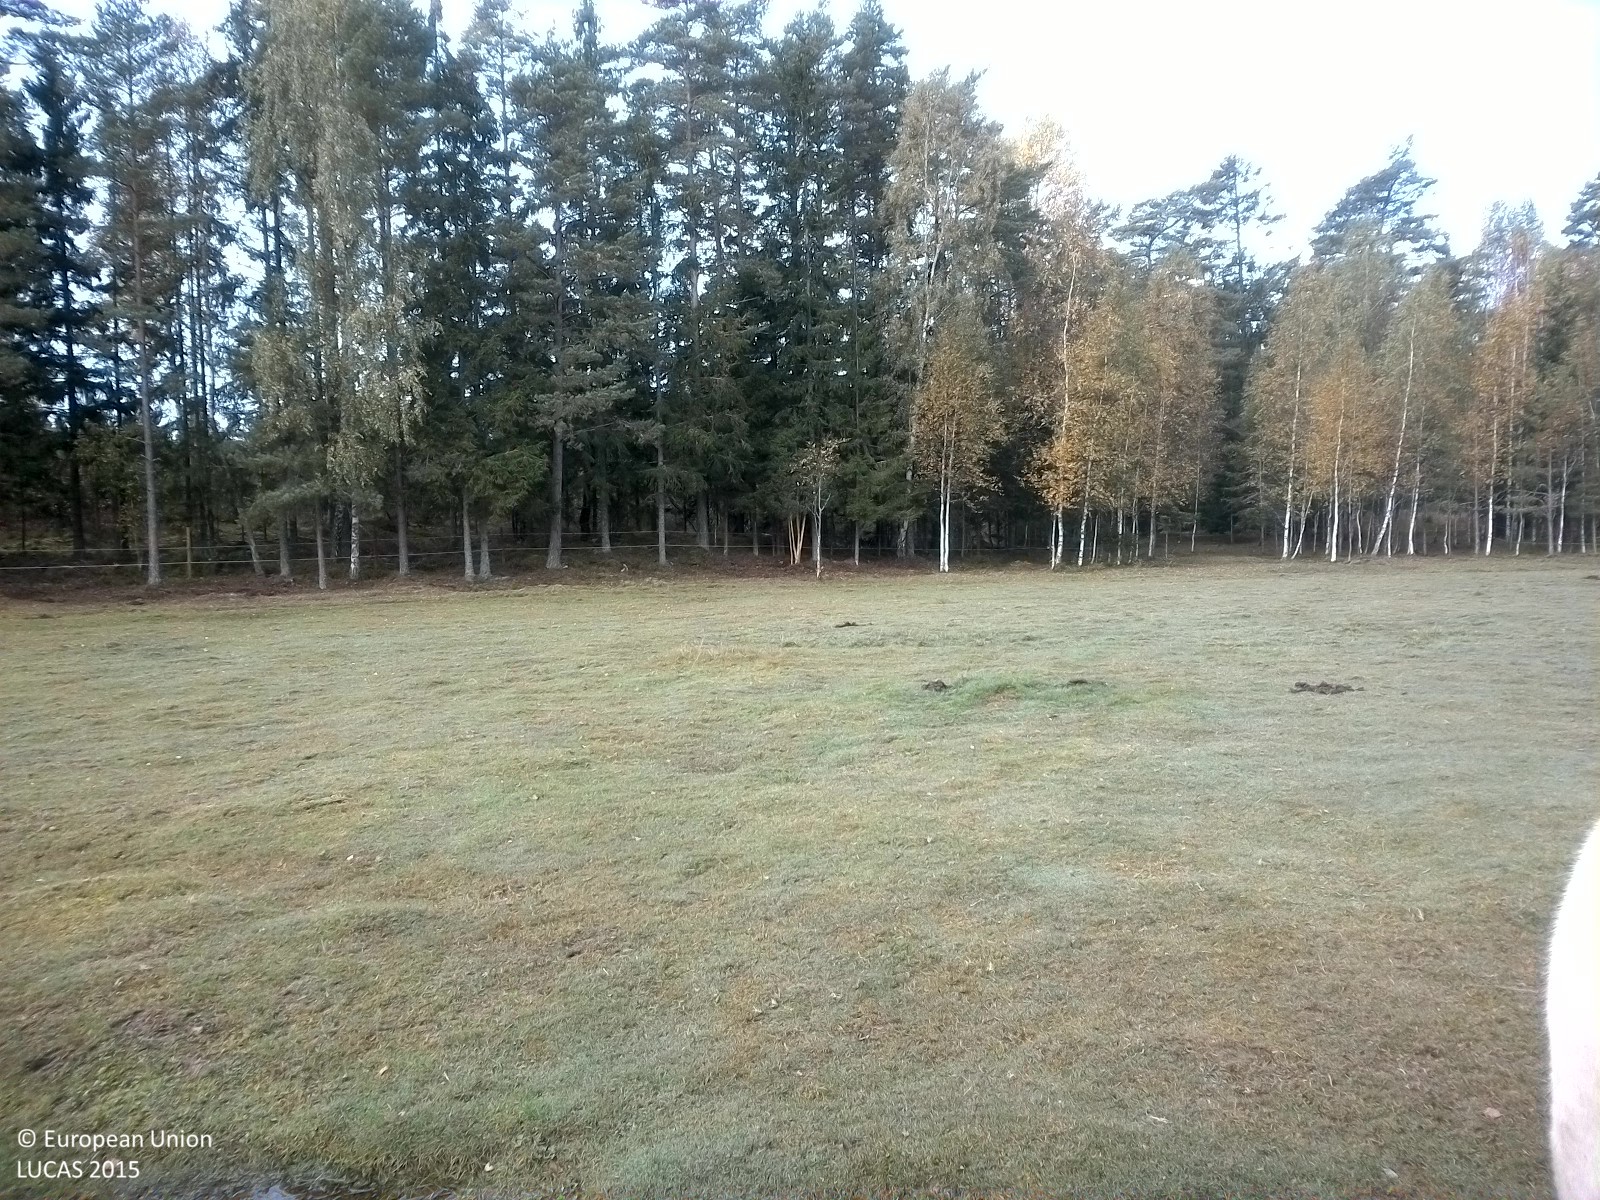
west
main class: Grassland
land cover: Grassland without tree/shrub cover
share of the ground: > 75 %
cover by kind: herbaceous plants 90 %, consolidated bare surface 10 %
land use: Agriculture (excluding fallow land and kitchen gardens)
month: September
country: SE
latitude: 58.6612
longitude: 16.8055
